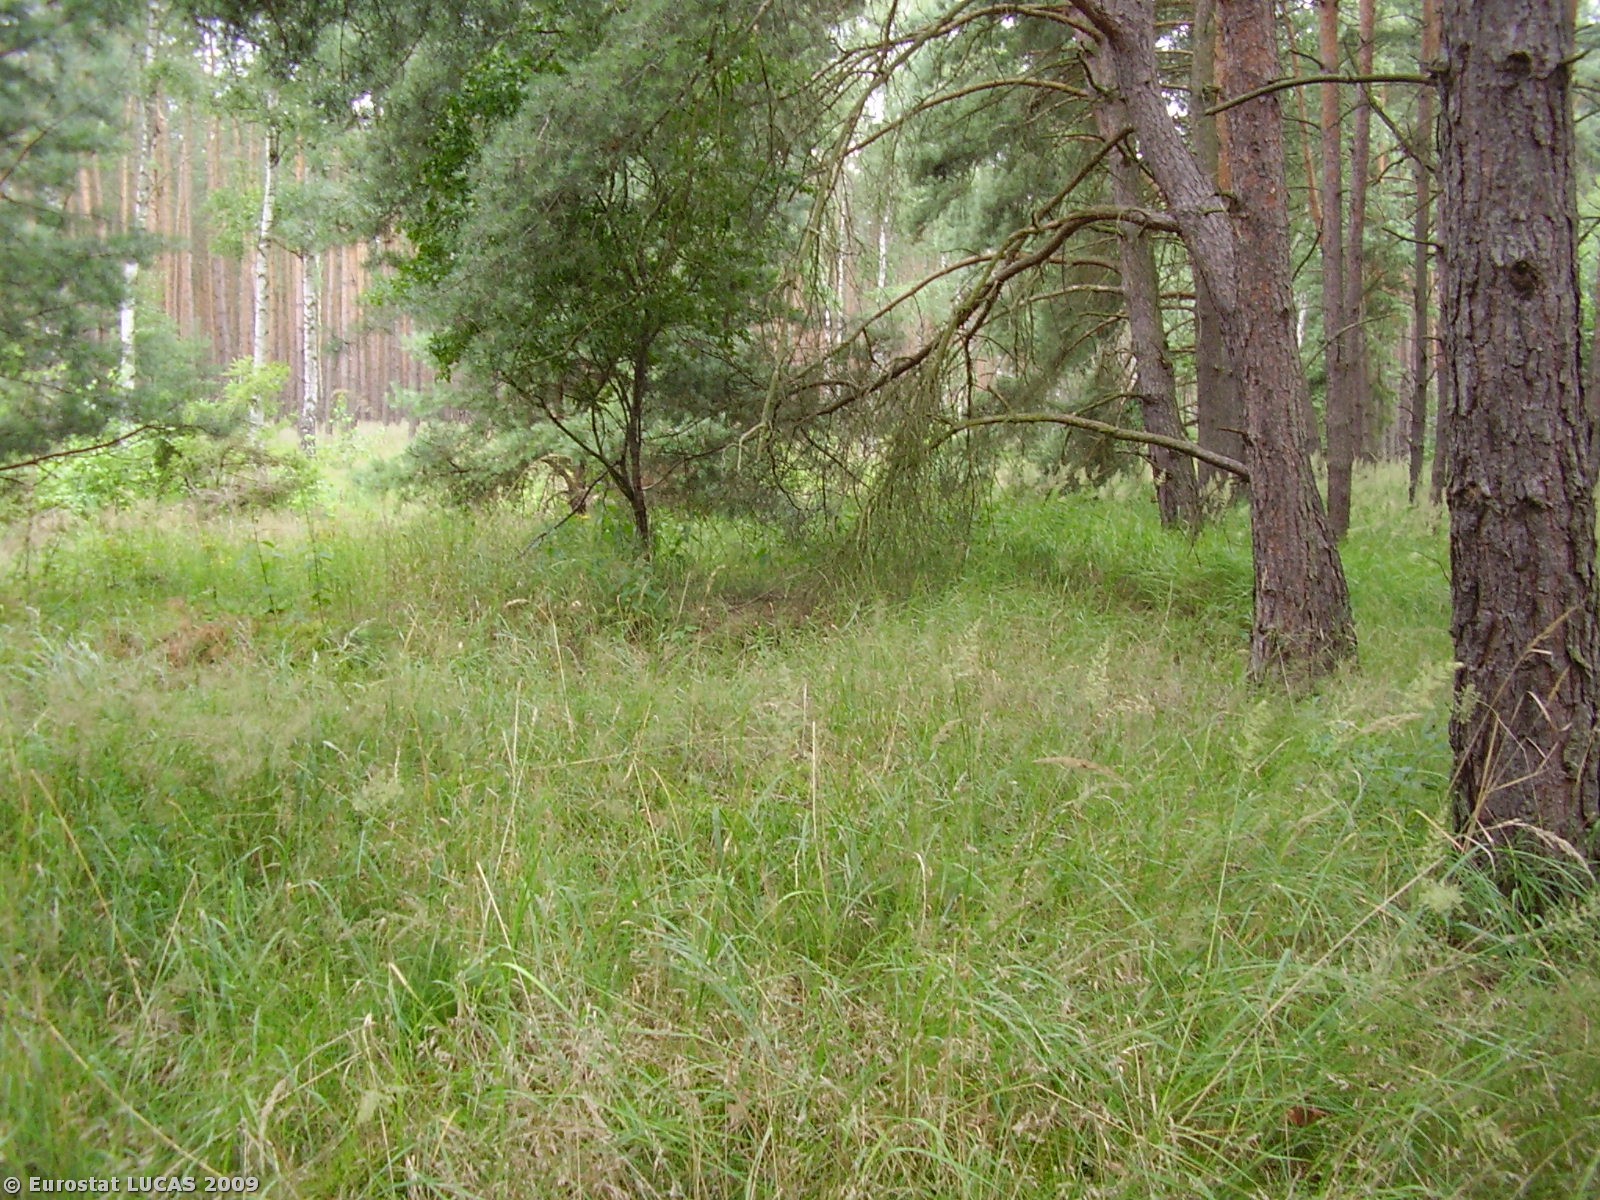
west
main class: Woodland
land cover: Coniferous woodland
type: hemiboreal forest and nemoral coniferous forest and mixed broadleaved-coniferous forest
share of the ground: > 75 %
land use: Forestry
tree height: > 5 m
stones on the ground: < 10 %
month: July
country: PL
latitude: 51.8499
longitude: 16.2928
